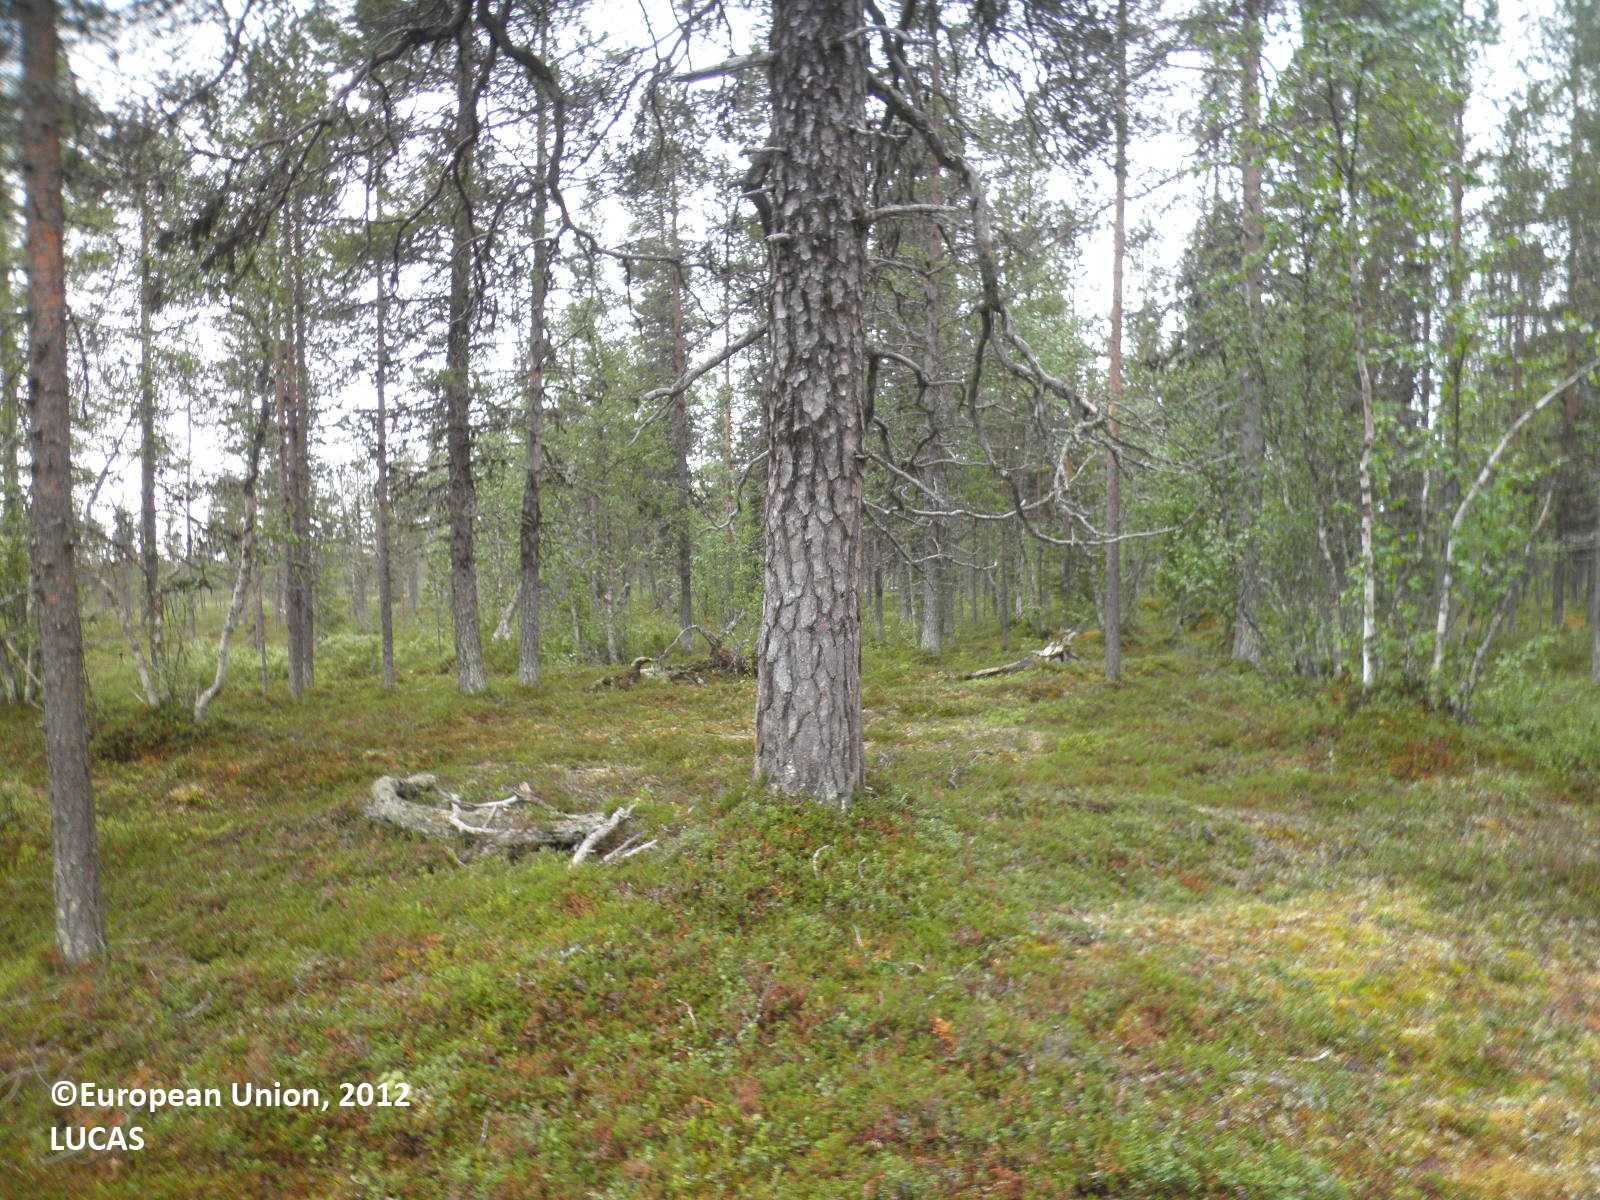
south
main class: Woodland
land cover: Pine dominated coniferous woodland
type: boreal forest
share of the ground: 50 - 75 %
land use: Forestry
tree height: > 5 m
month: July
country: FI
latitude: 68.2123
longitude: 25.6610
